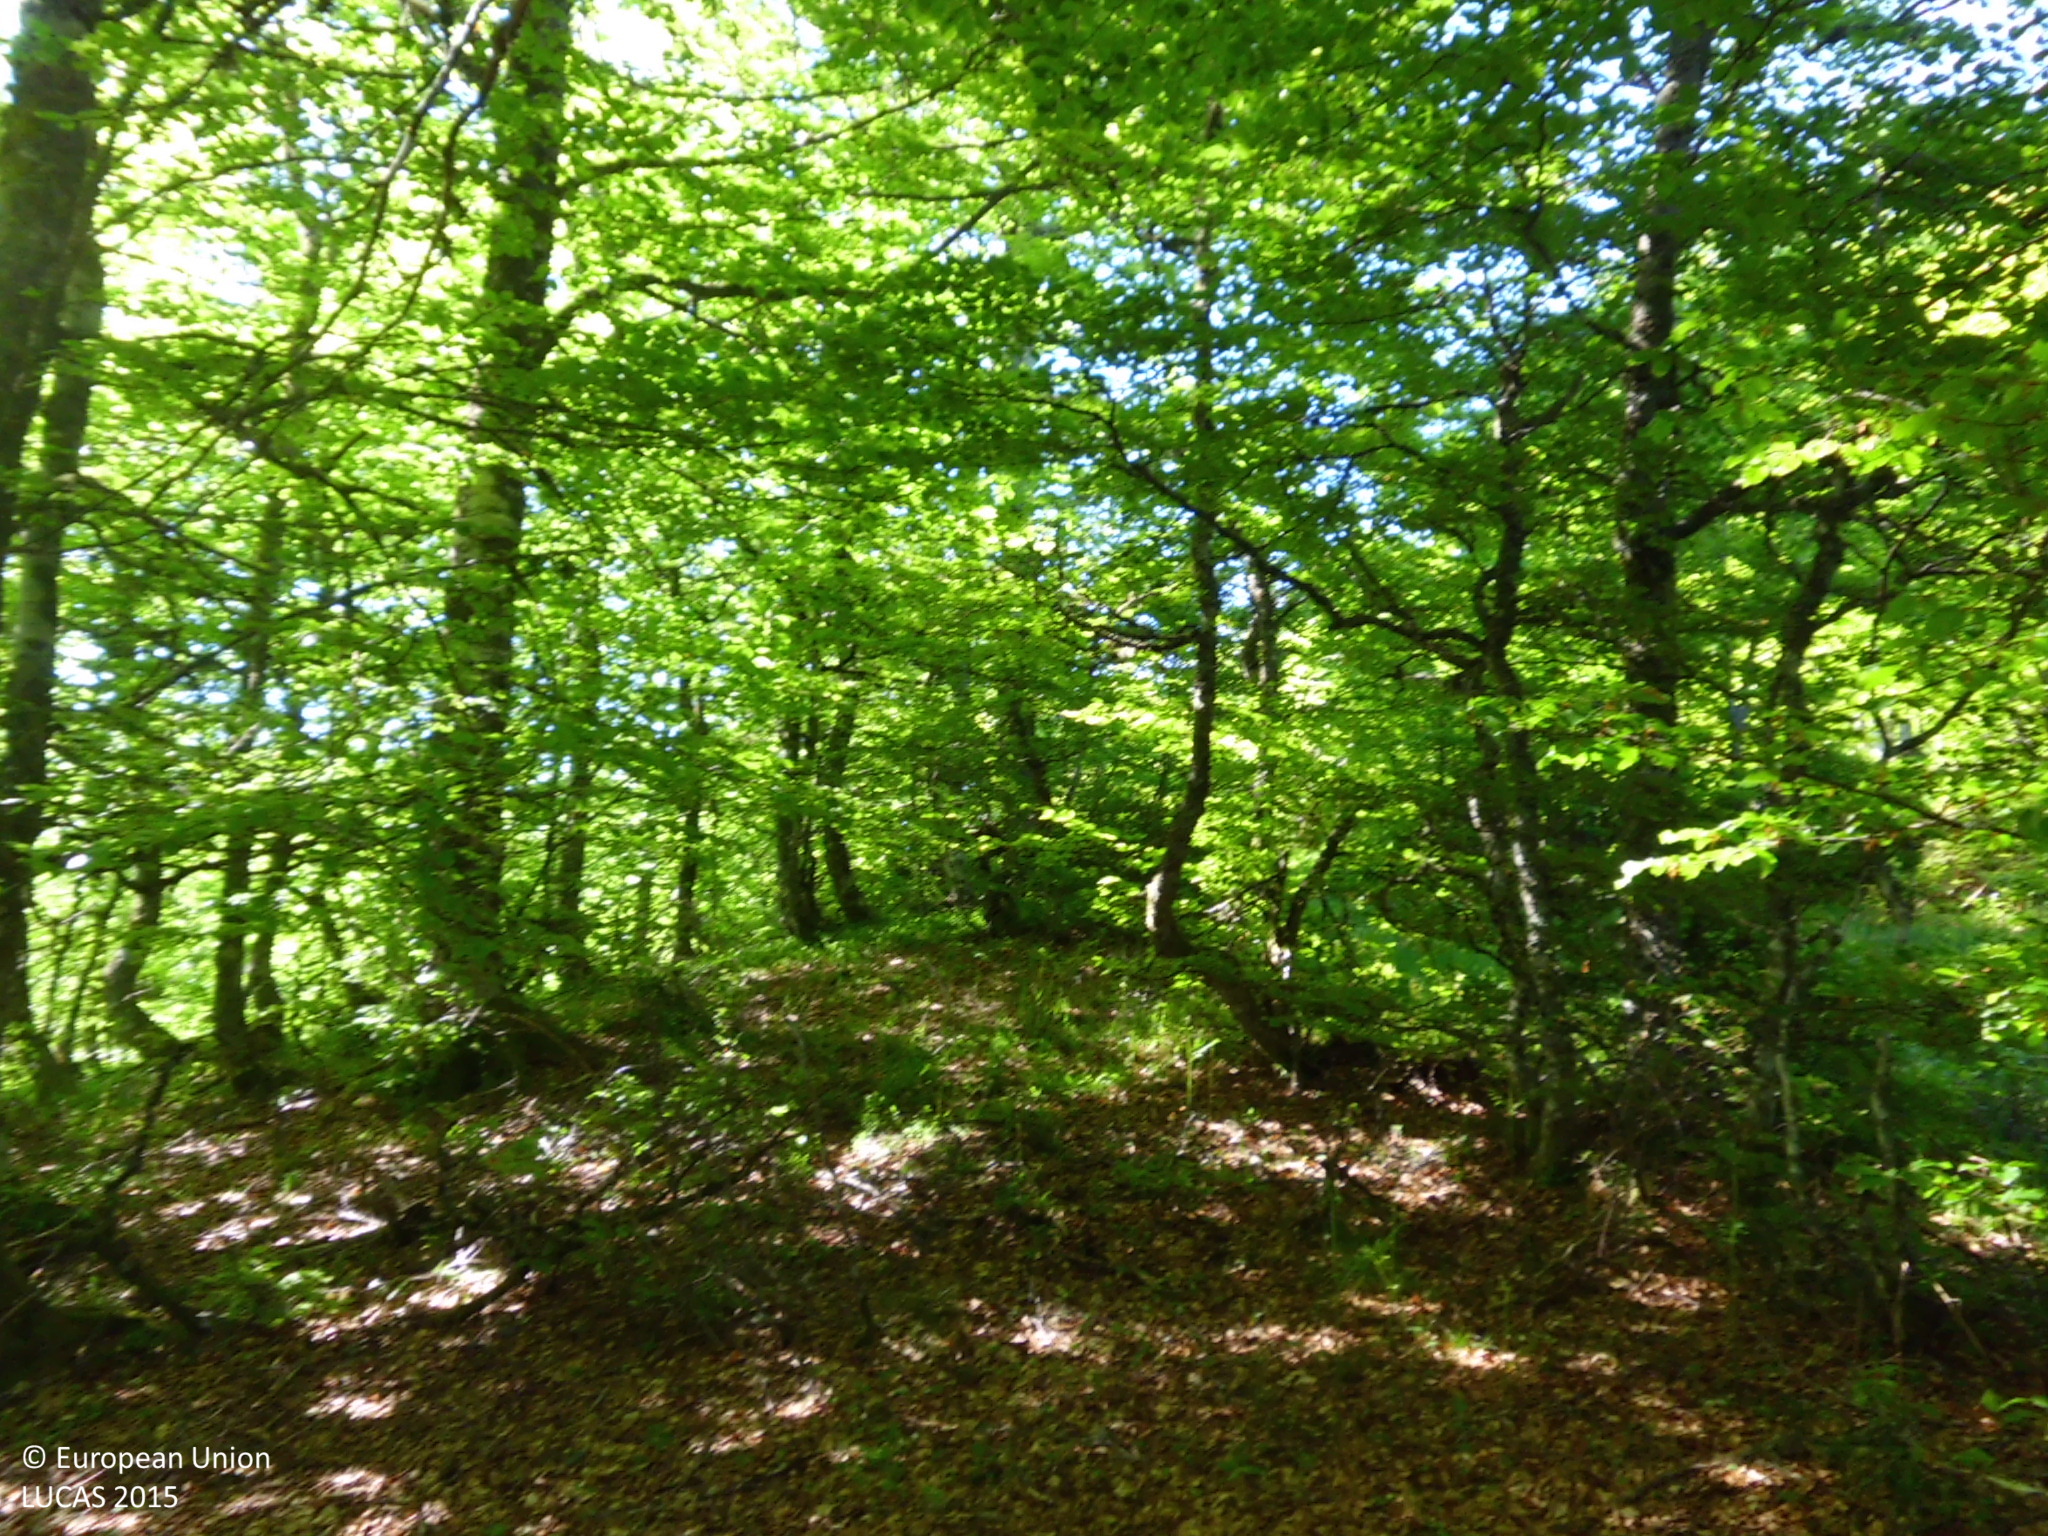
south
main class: Woodland
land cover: Broadleaved woodland
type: mountainous beech forest
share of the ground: 50 - 75 %
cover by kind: broadleaved forest trees 70 %, herbaceous plants 25 %, shrubs 5 %
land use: Semi-natural and natural areas not in use
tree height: > 5 m
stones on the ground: > 50 %
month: May
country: ES
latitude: 43.1032
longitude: -5.0210
